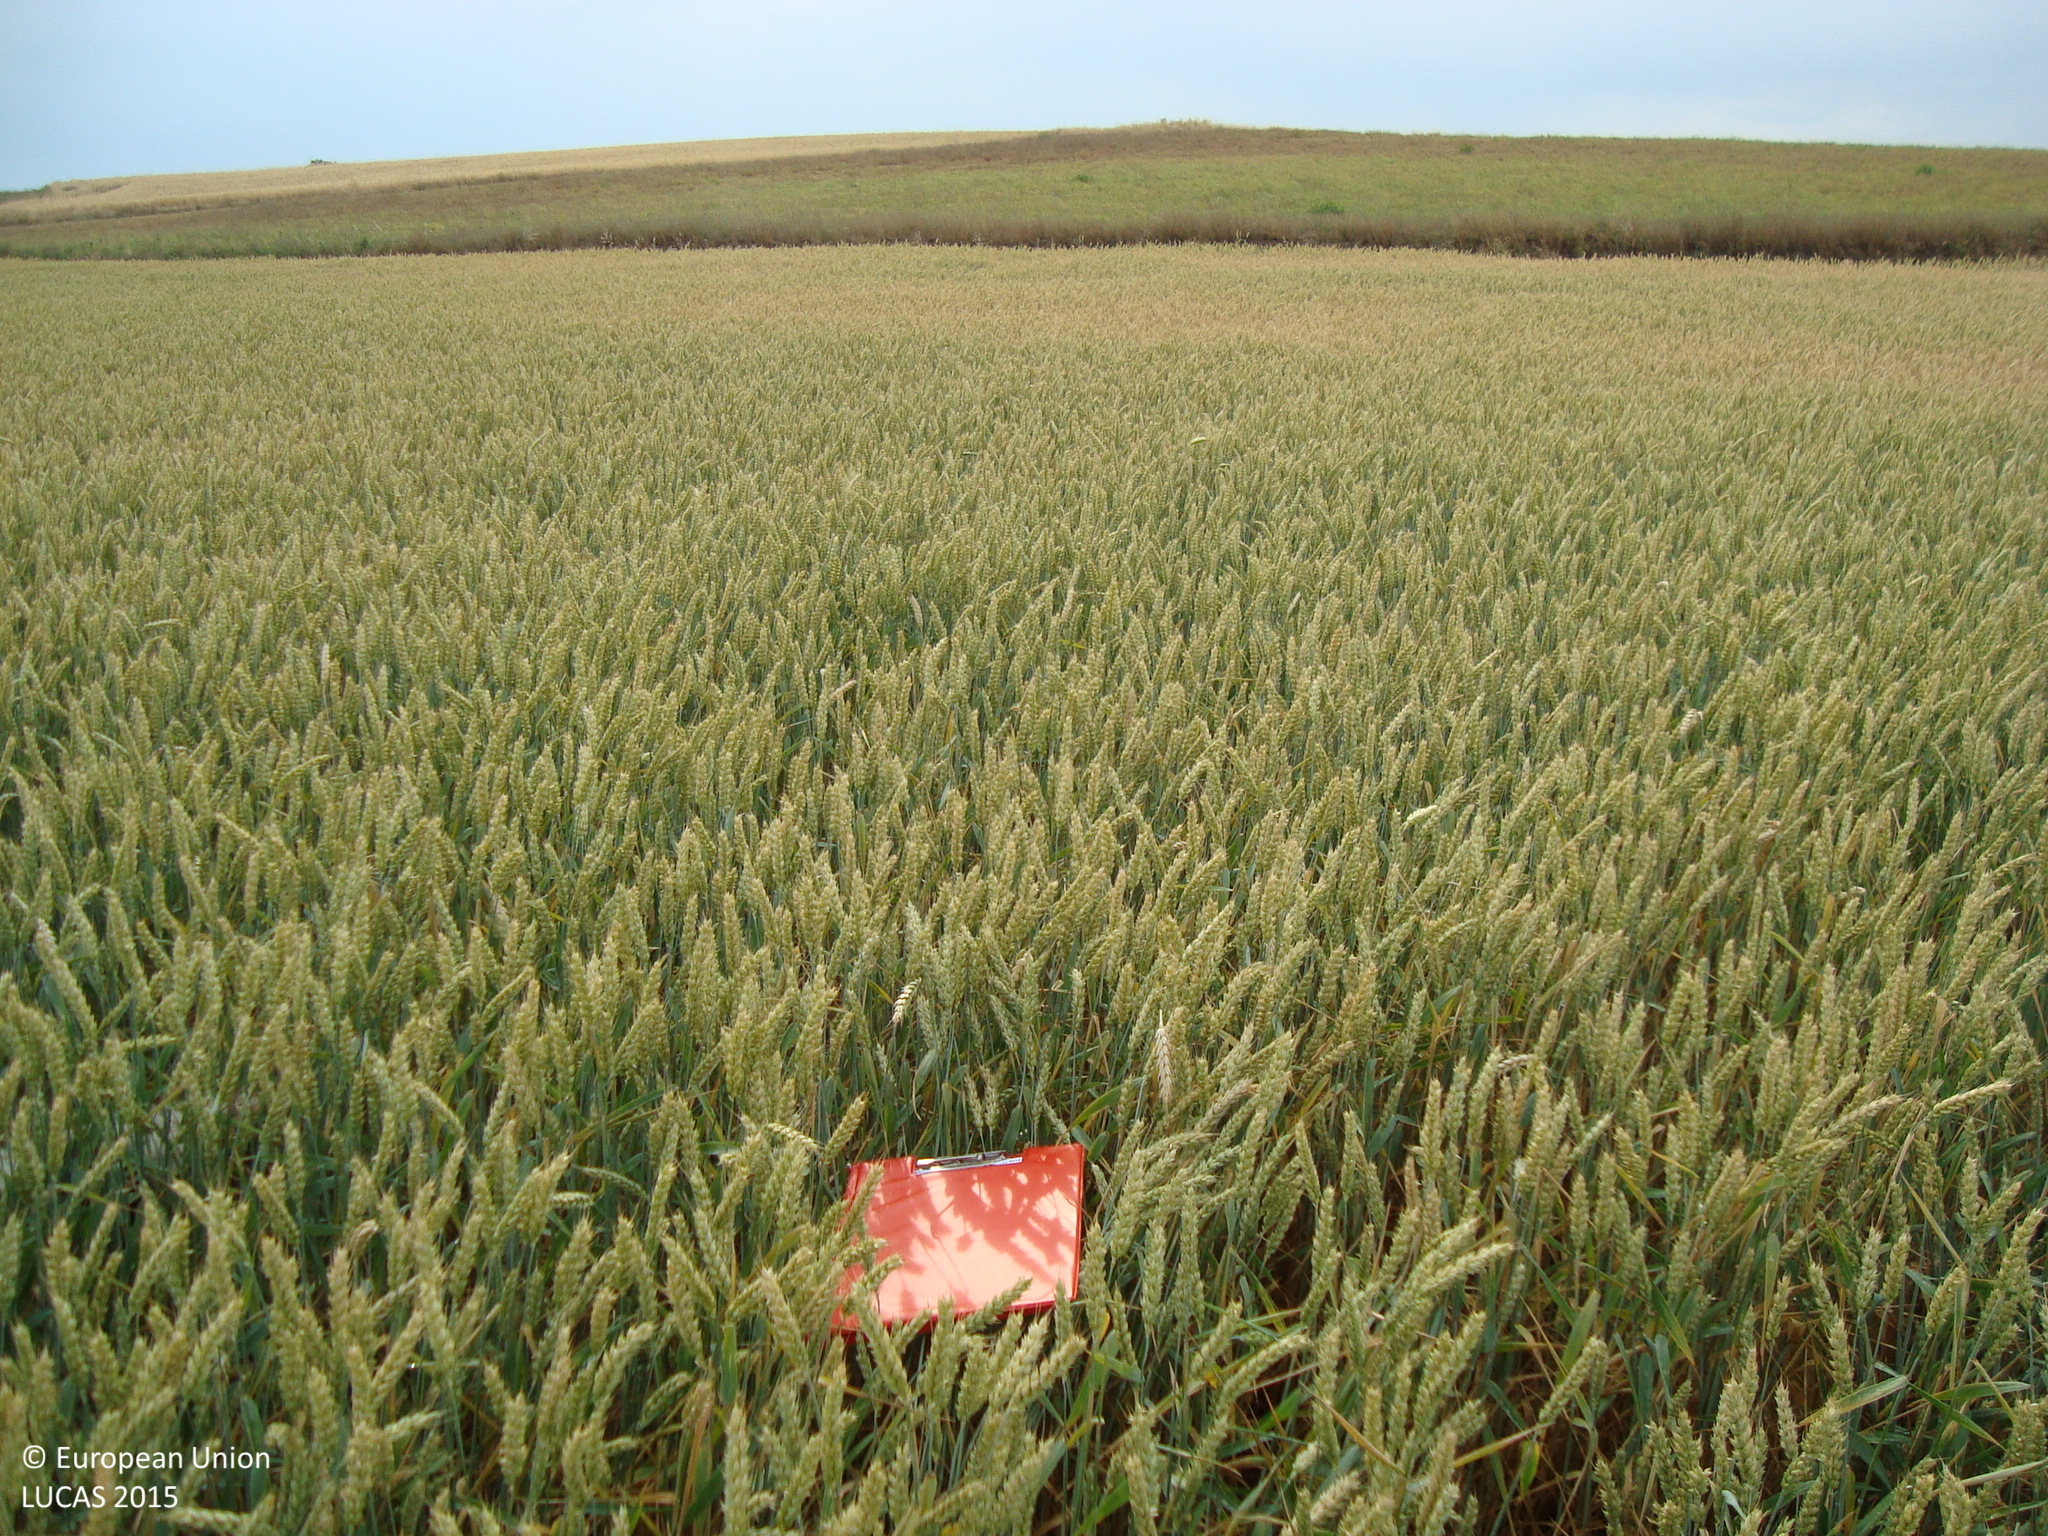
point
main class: Cropland
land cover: Common wheat
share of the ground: > 75 %
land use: Agriculture (excluding fallow land and kitchen gardens)
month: June
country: ES
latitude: 41.8540
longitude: -3.7758
